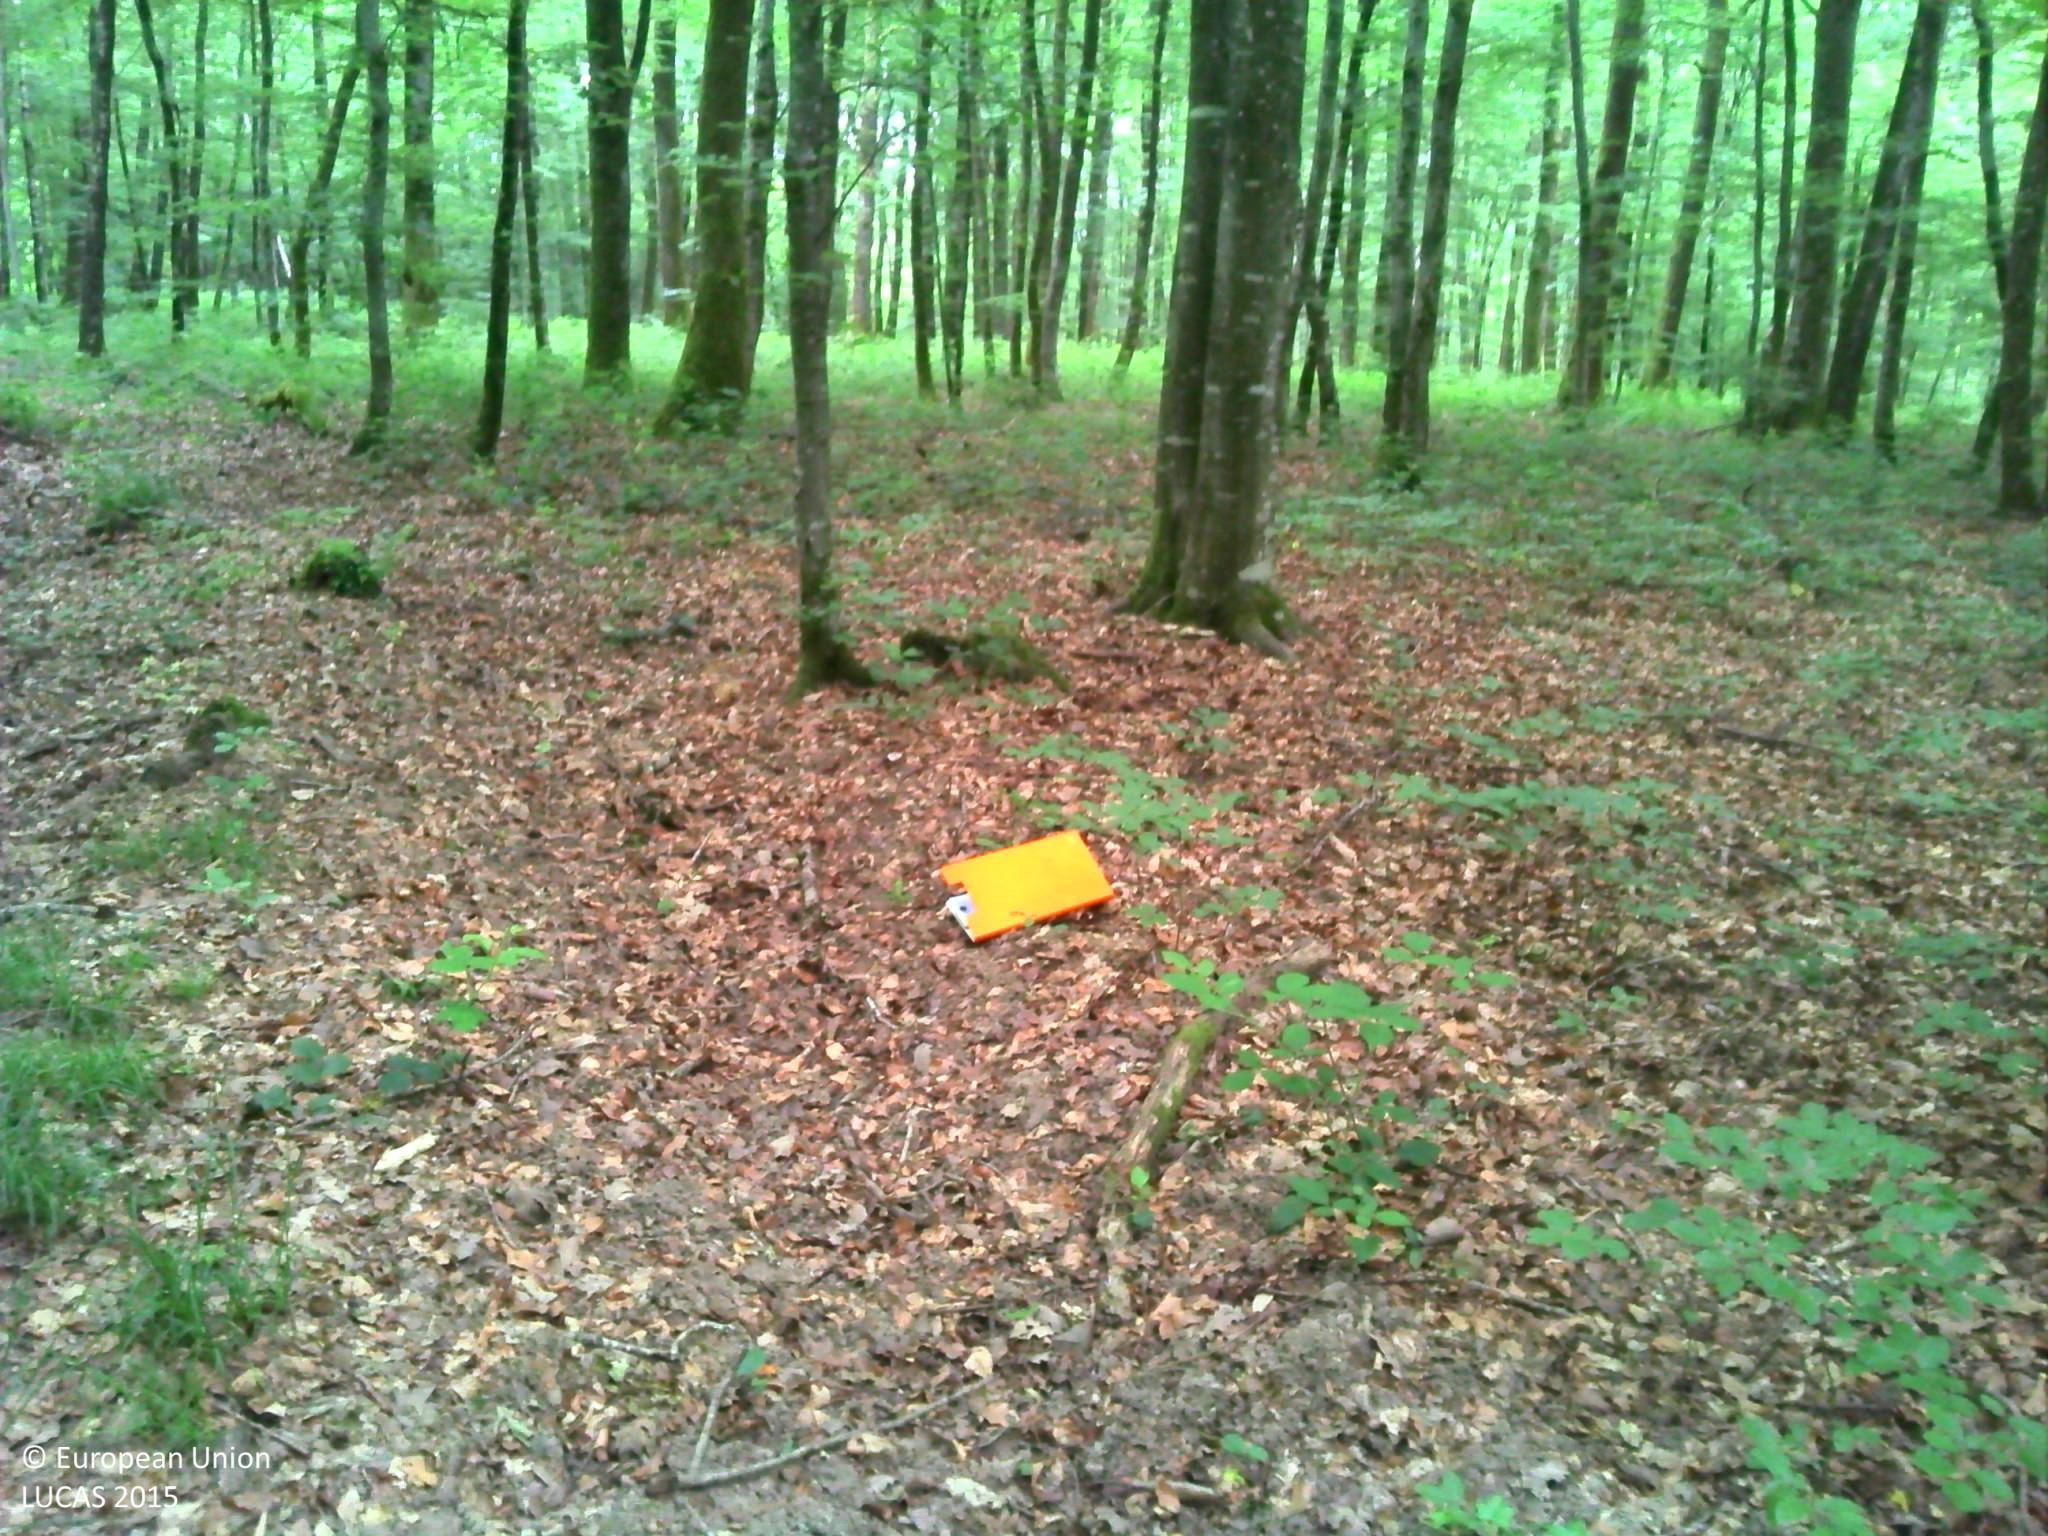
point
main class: Woodland
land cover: Broadleaved woodland
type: beech forest
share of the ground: > 75 %
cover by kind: broadleaved forest trees 95 %, herbaceous plants 5 %
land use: Forestry
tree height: > 5 m
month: June
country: FR
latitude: 47.7409
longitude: 6.1202
